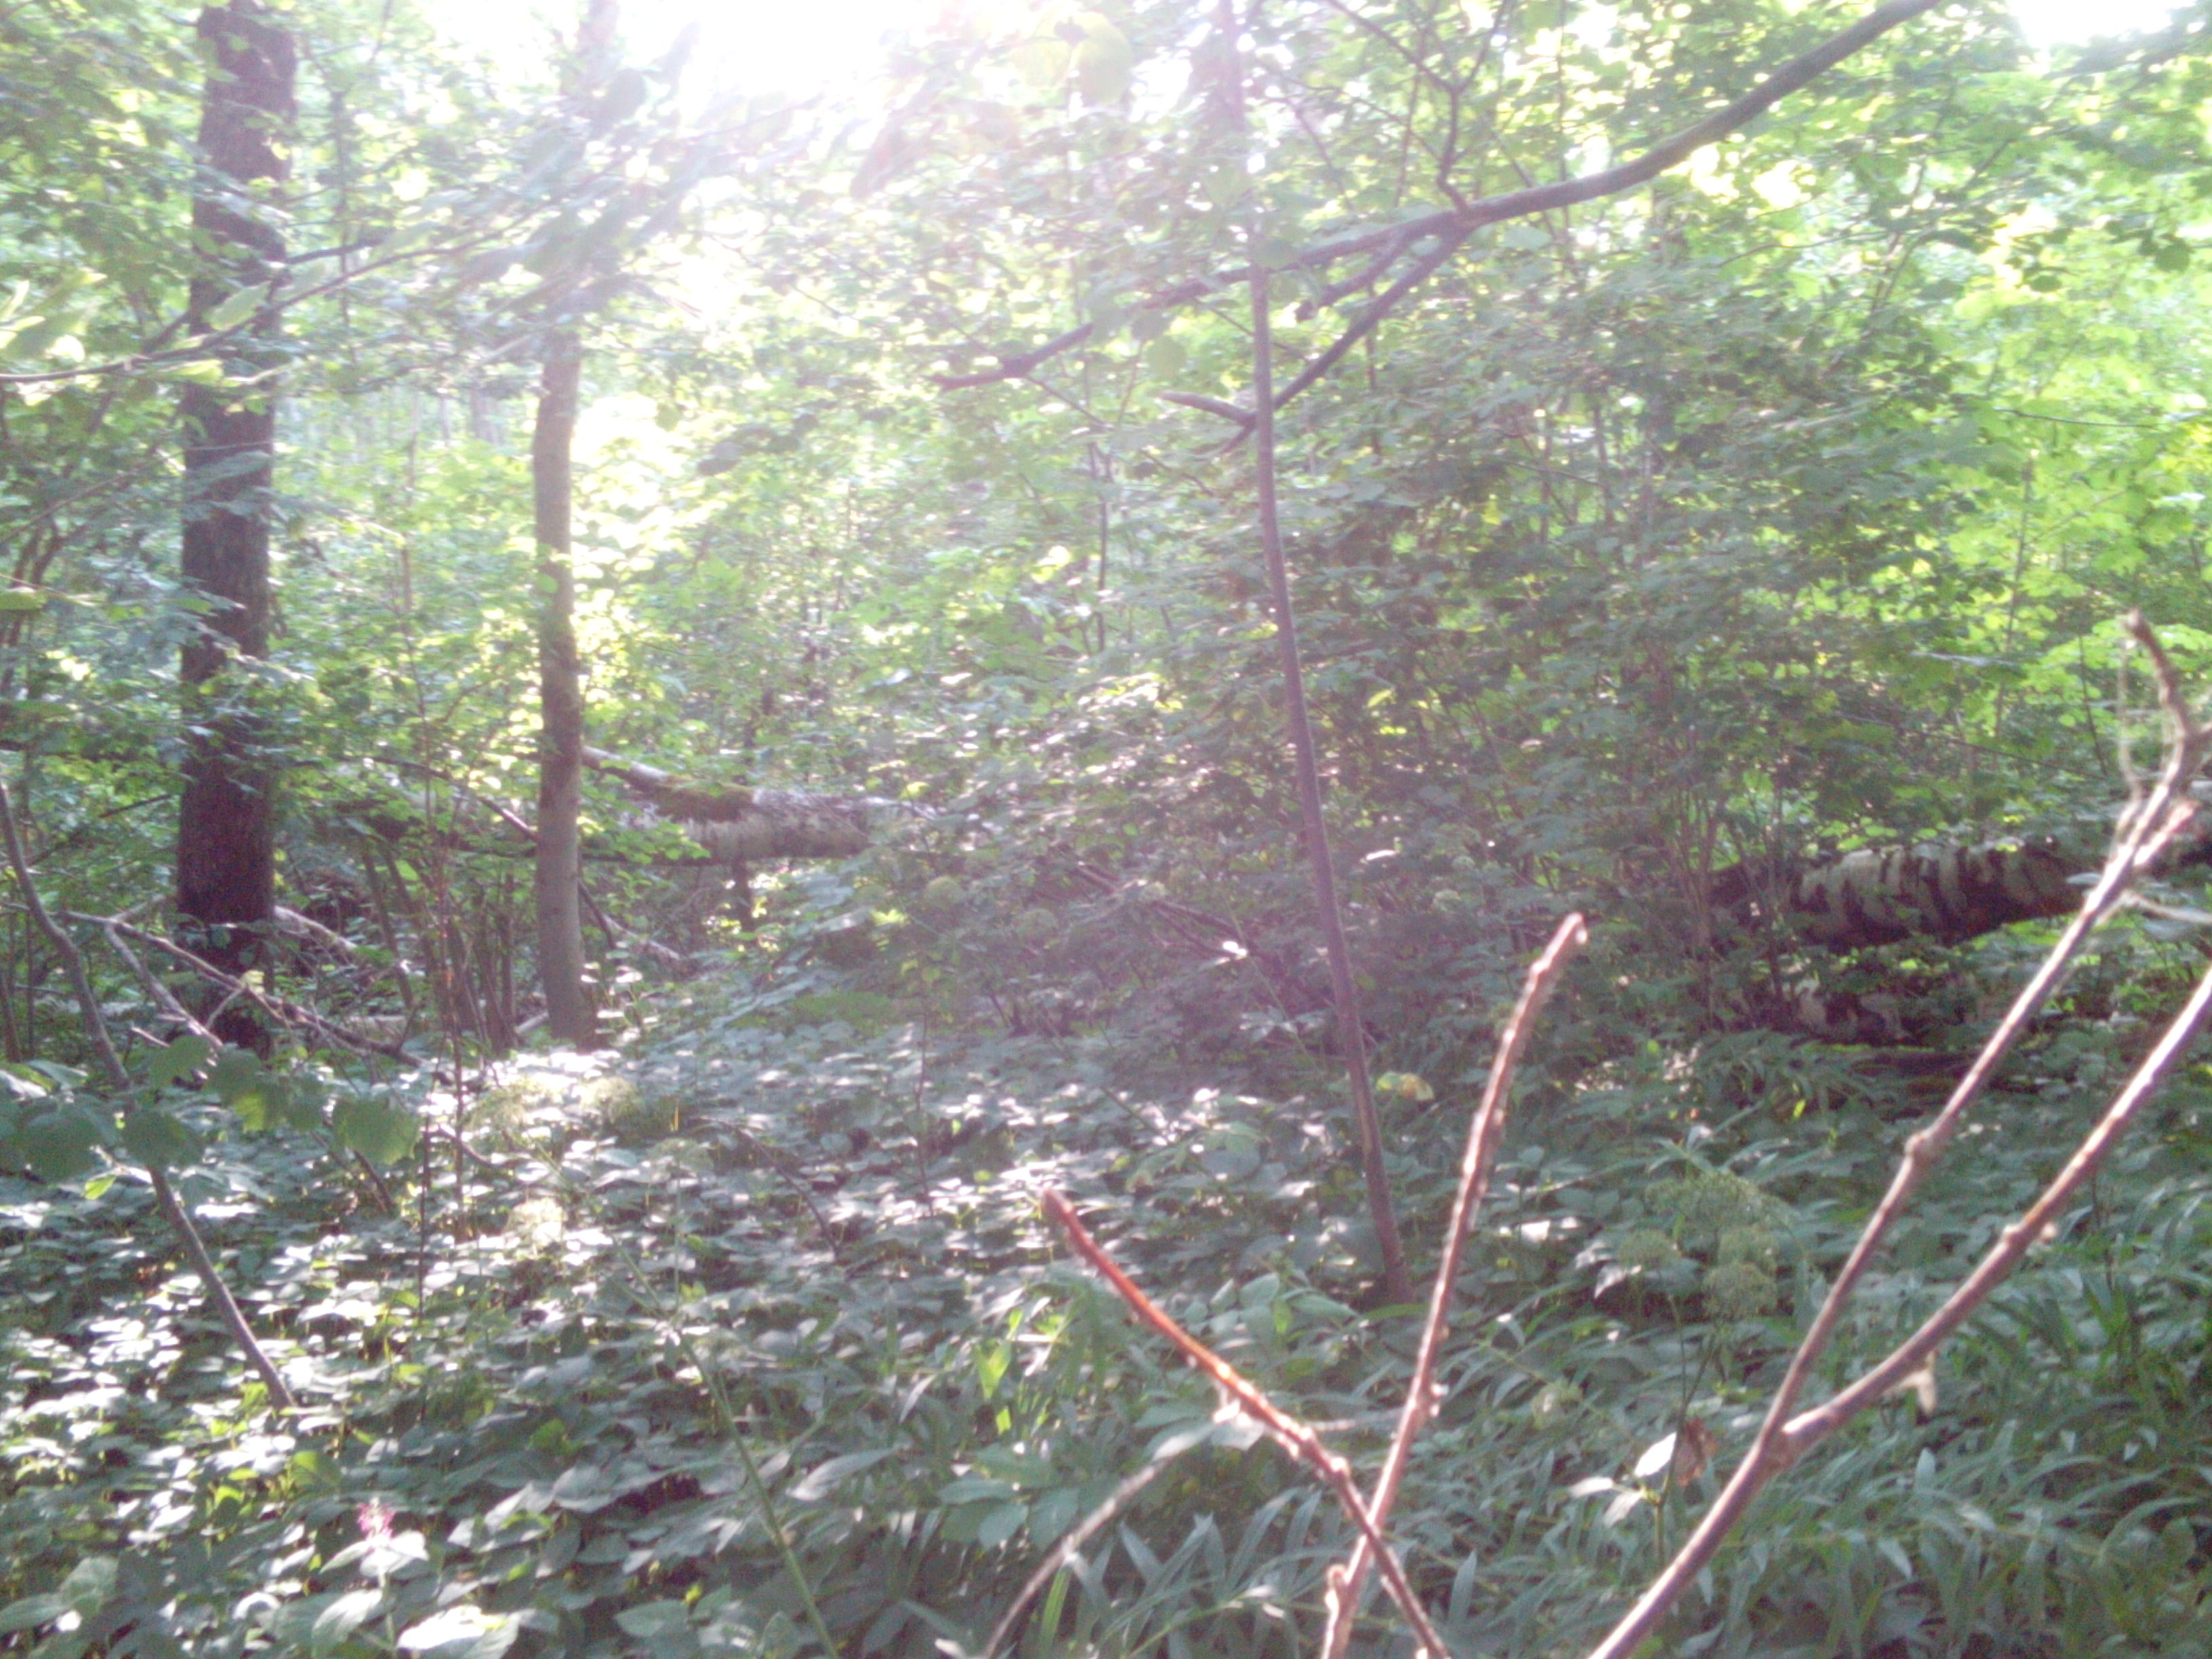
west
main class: Woodland
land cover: Broadleaved woodland
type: non-riverine alder, birch or aspen forest
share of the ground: > 75 %
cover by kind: broadleaved forest trees 85 %, herbaceous plants 10 %, shrubs 5 %
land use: Forestry
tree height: > 5 m
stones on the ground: < 10 %
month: July
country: LV
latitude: 56.5118
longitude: 21.8283
